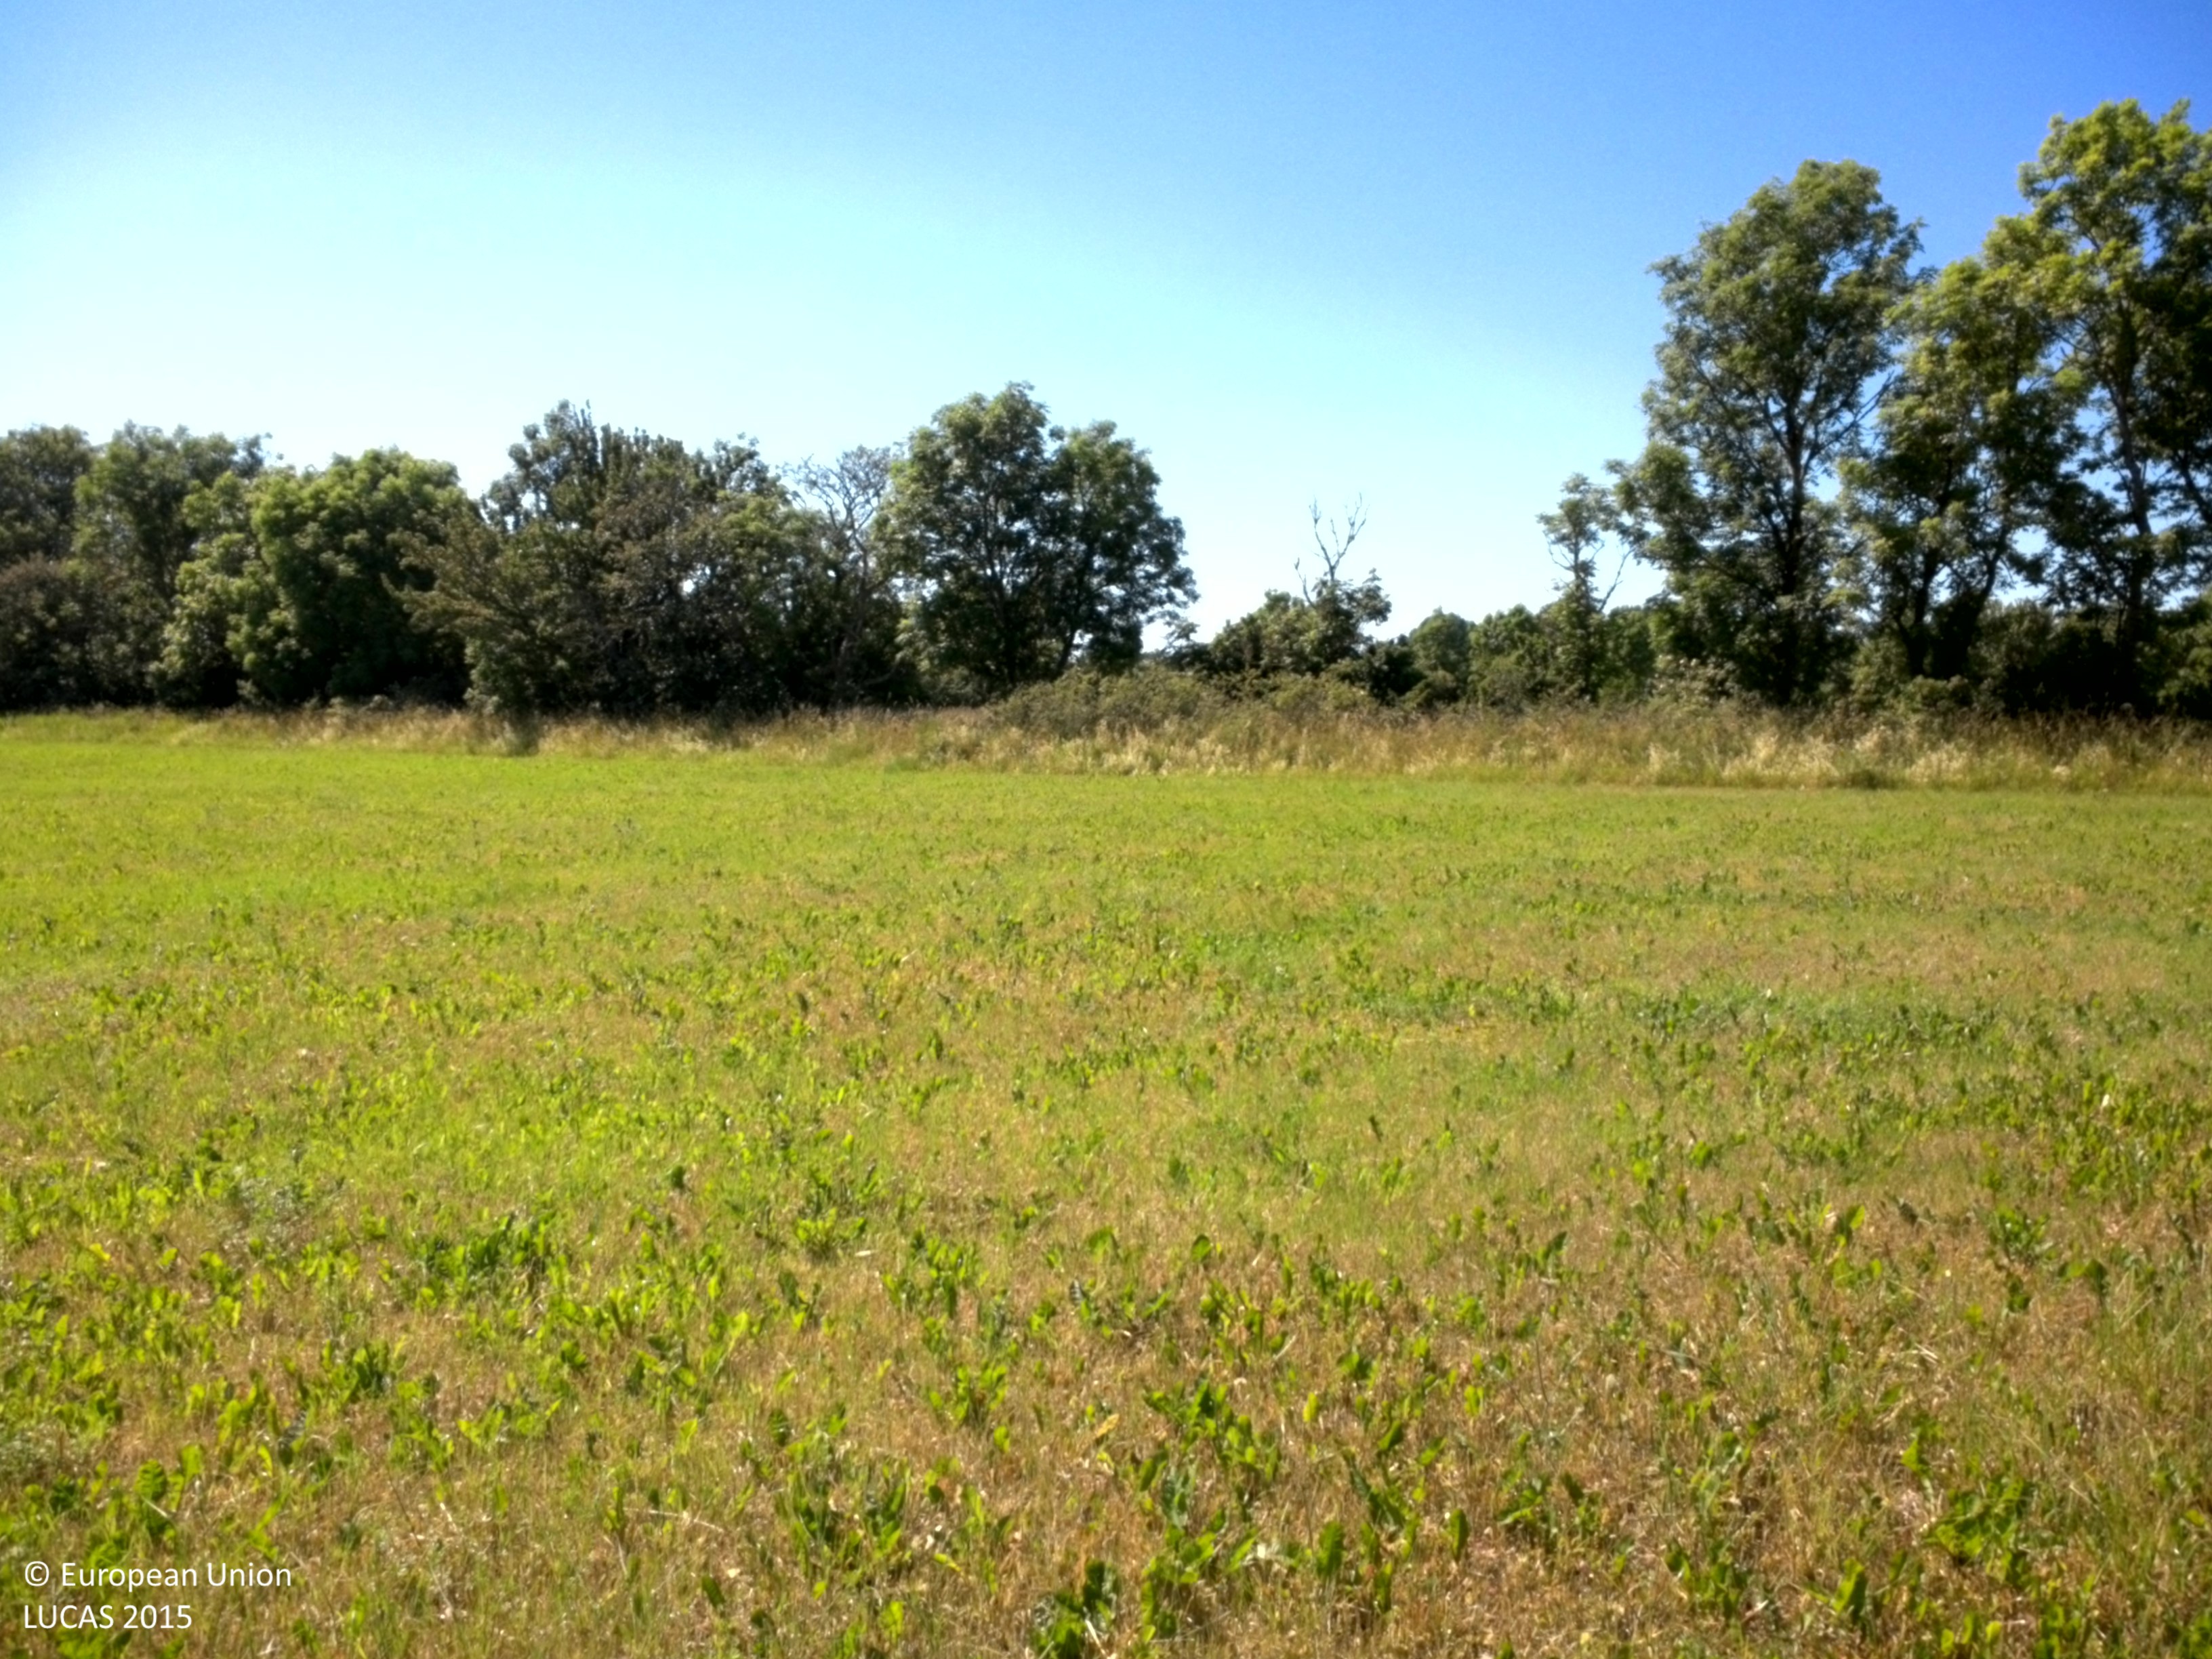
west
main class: Grassland
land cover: Grassland without tree/shrub cover
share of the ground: > 75 %
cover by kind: herbaceous plants 100 %
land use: Agriculture (excluding fallow land and kitchen gardens)
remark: Harvested field
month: July
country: SE
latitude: 57.7809
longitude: 18.8725
